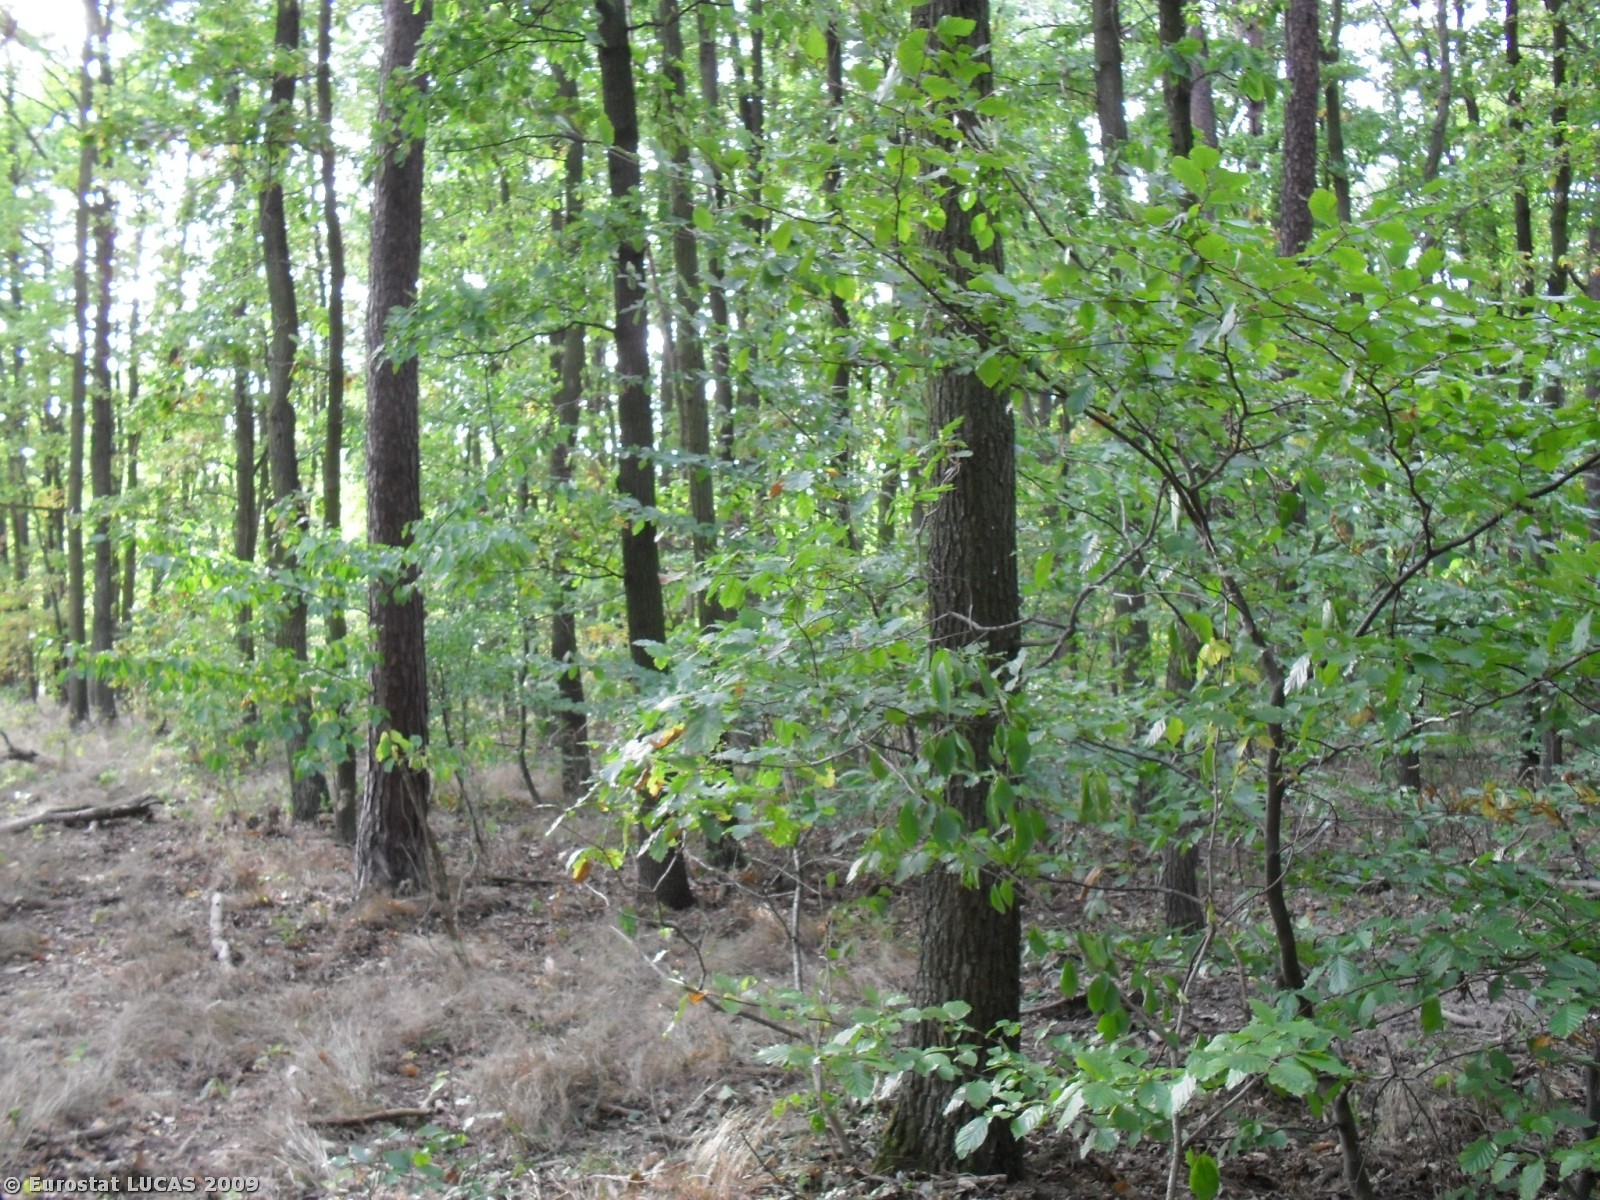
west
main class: Woodland
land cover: Mixed woodland
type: hemiboreal forest and nemoral coniferous forest and mixed broadleaved-coniferous forest
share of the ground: > 75 %
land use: Forestry
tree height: > 5 m
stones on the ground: < 10 %
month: September
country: PL
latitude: 51.6571
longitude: 20.6943
